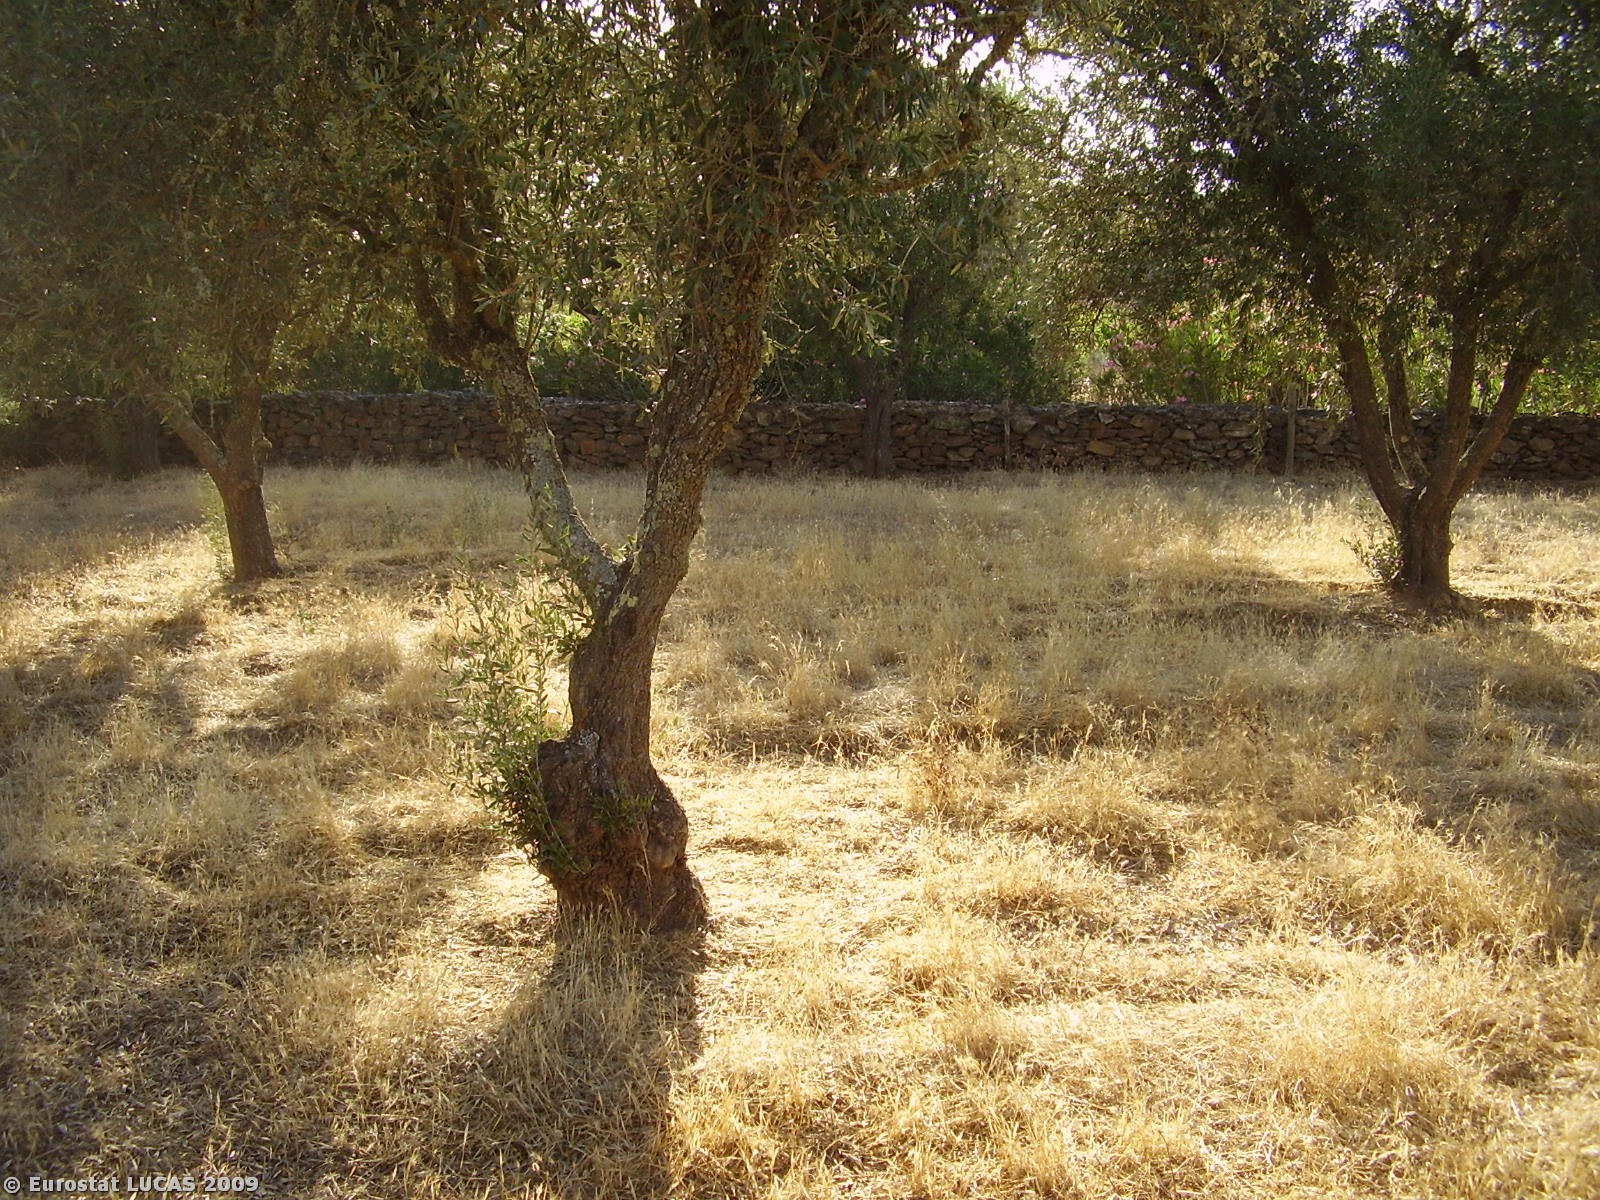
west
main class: Cropland
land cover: Olive groves
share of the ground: 25 - 50 %
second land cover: Spontaneously vegetated surfaces
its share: 50 - 75 %
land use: Agriculture (excluding fallow land and kitchen gardens)
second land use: Fallow land
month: July
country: PT
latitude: 37.7454
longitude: -7.7580
